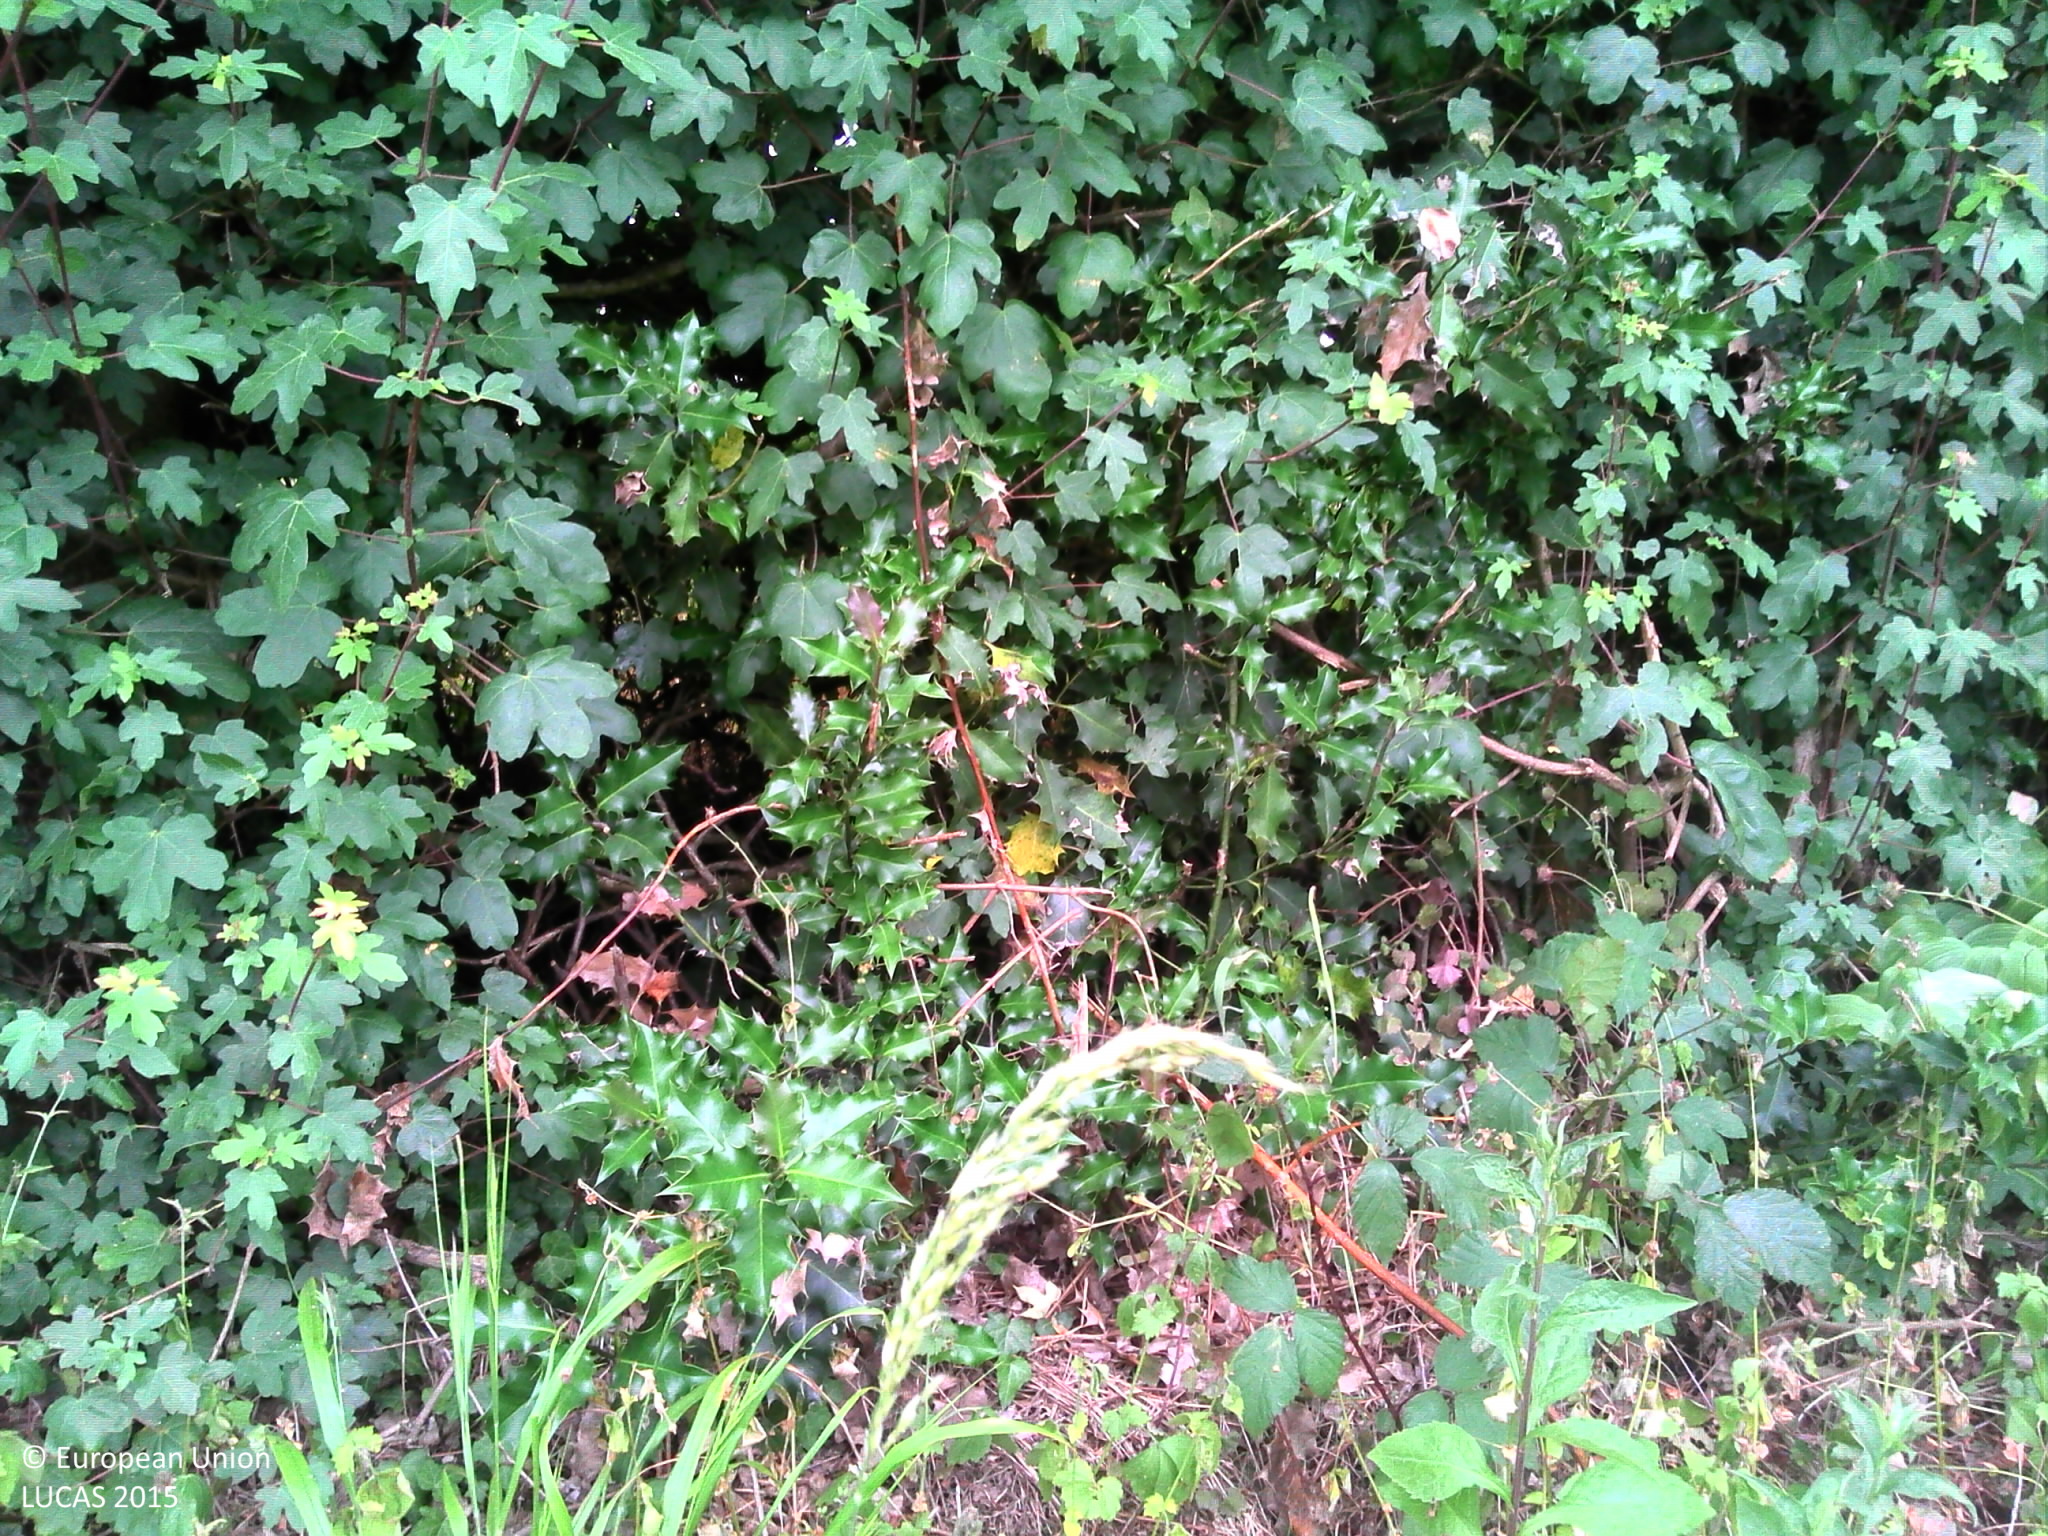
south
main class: Cropland
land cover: Rye
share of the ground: > 75 %
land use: Agriculture (excluding fallow land and kitchen gardens)
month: June
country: FR
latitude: 46.1940
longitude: 4.9102
